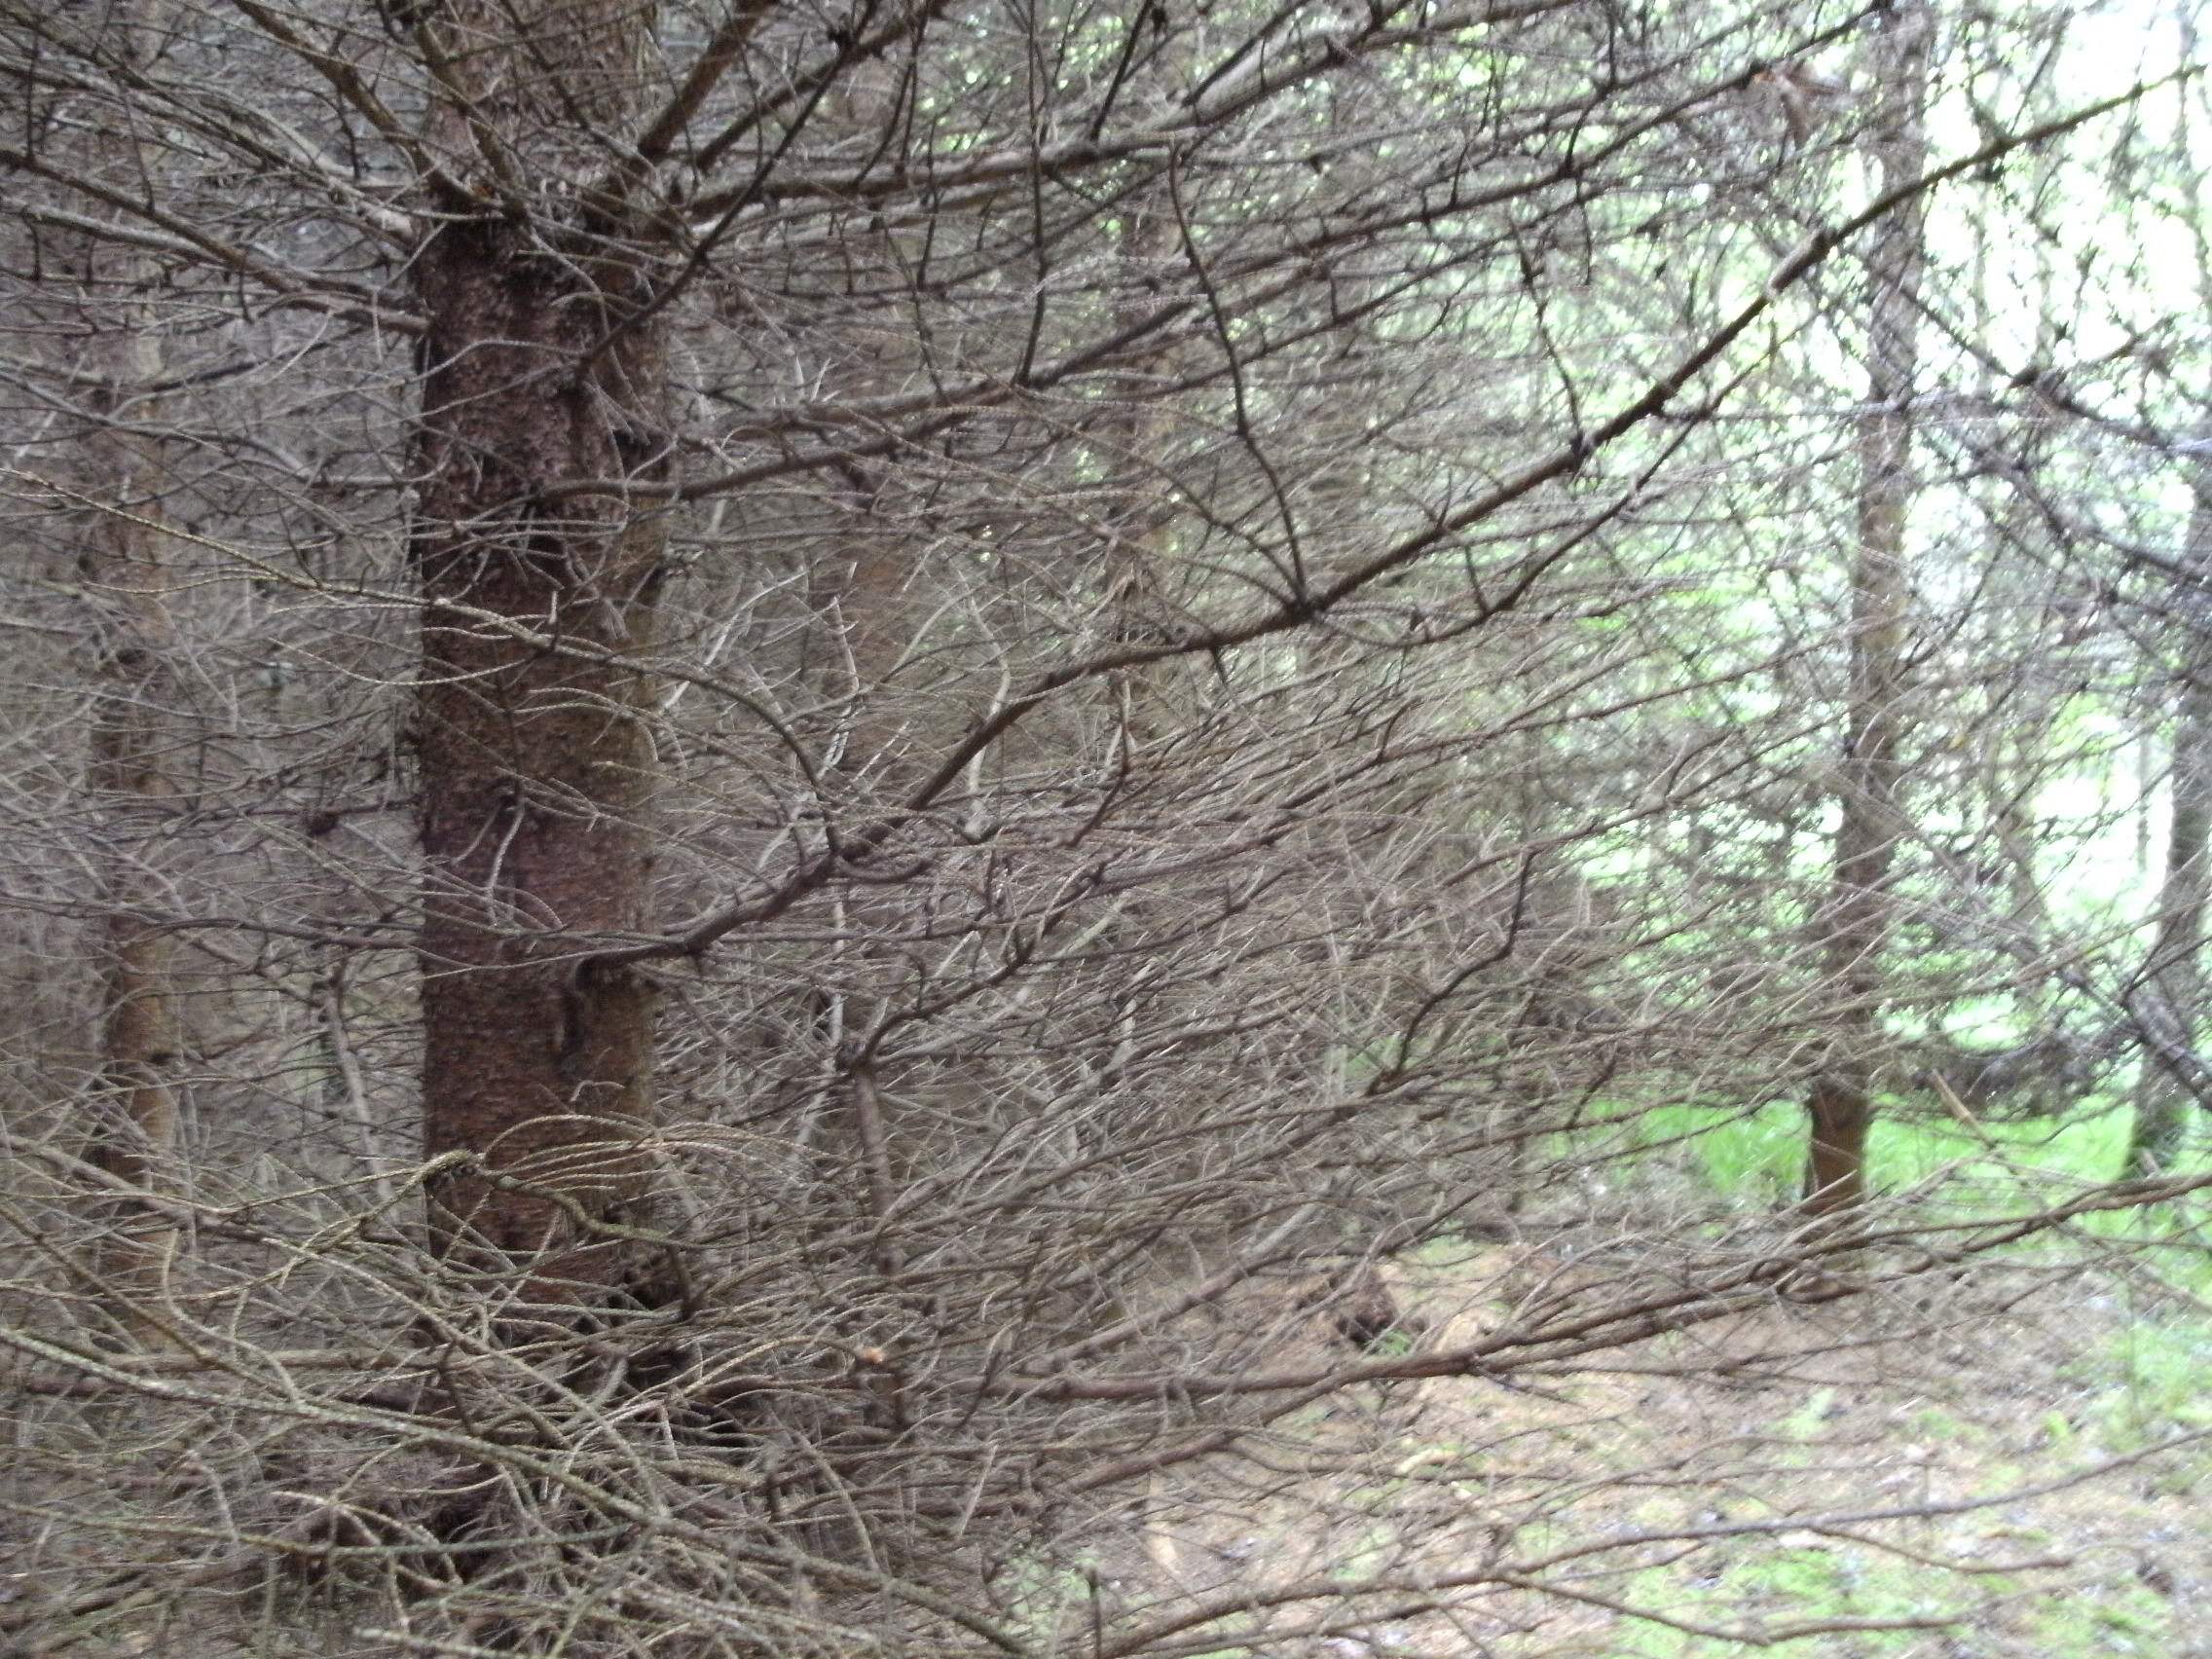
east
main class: Woodland
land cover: Spruce dominated coniferous woodland
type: hemiboreal forest and nemoral coniferous forest and mixed broadleaved-coniferous forest
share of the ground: > 75 %
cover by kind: coniferous forest trees 95 %, unconsolidated bare surface 5 %
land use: Forestry
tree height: > 5 m
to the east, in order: Spruce dominated coniferous woodland; Broadleaved woodland; Other coniferous woodland; Other mixed woodland; Spruce dominated mixed woodland; Spruce dominated coniferous woodland; Spruce dominated mixed woodland
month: May
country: AT
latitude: 48.4031
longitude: 13.4710
